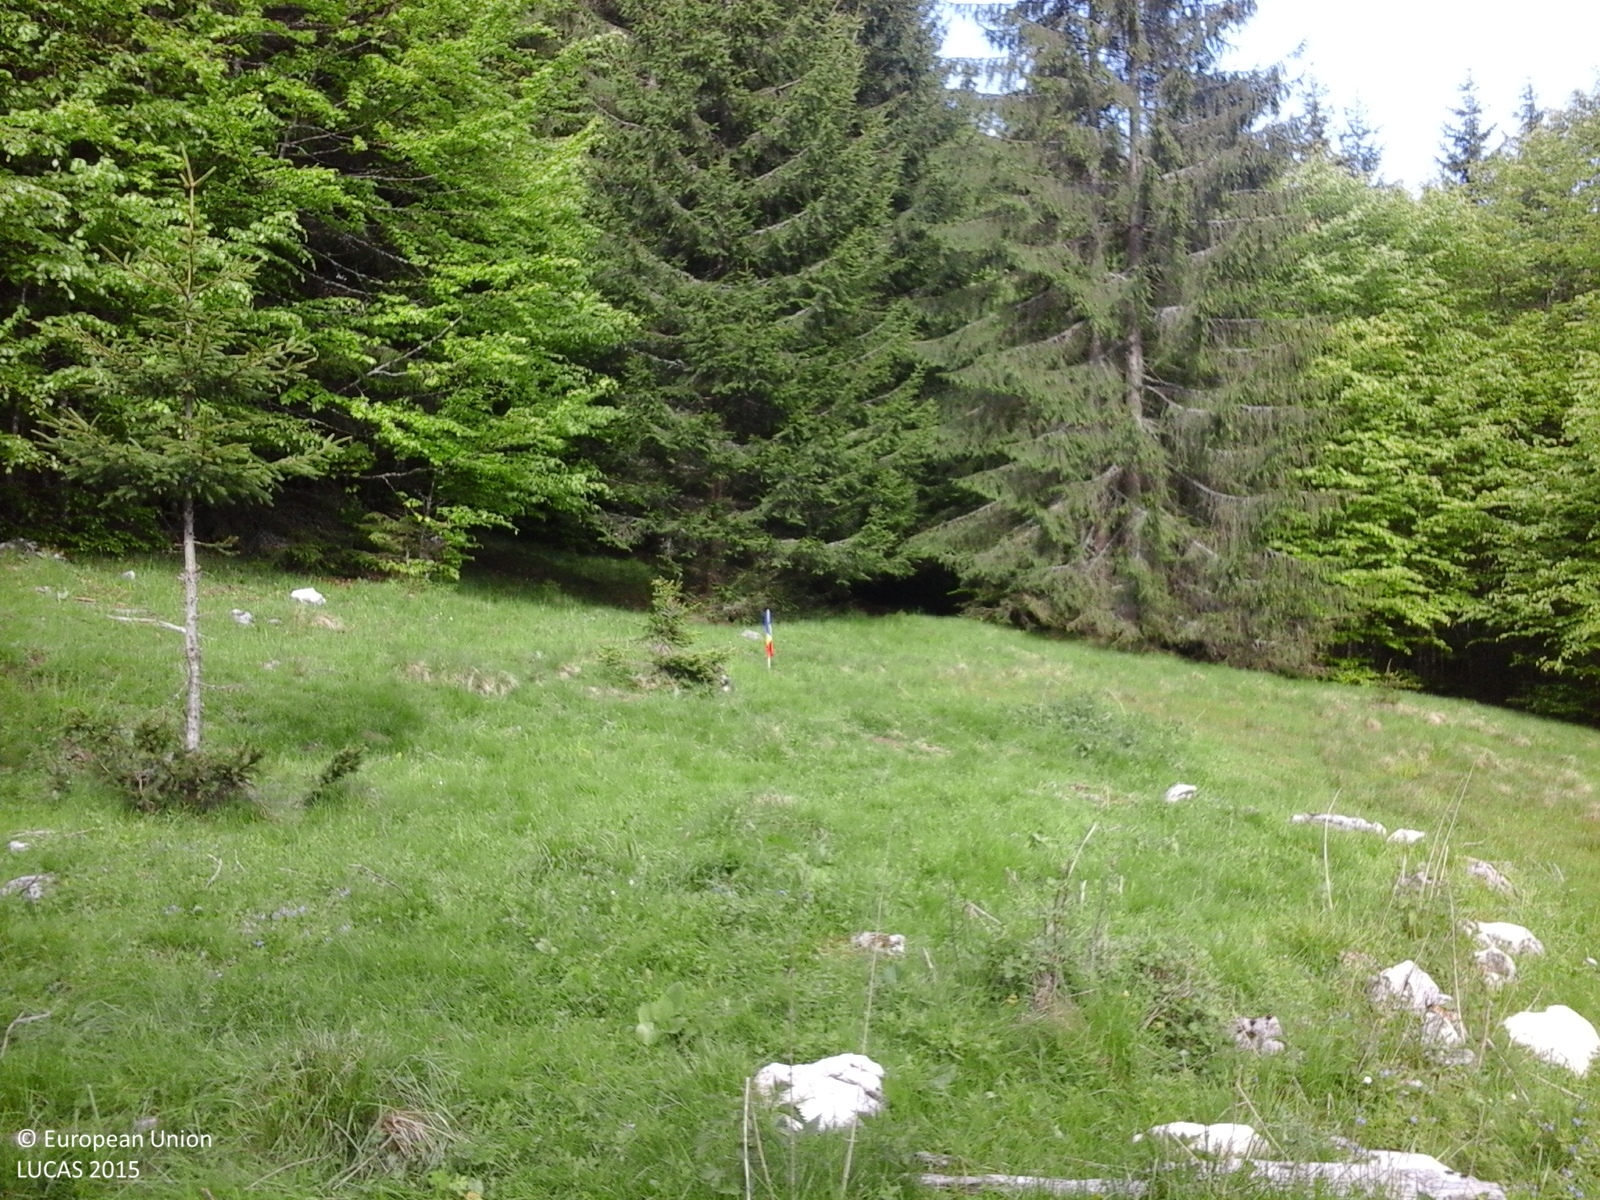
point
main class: Grassland
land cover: Grassland with sparse tree/shrub cover
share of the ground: > 75 %
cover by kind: herbaceous plants 90 %, coniferous forest trees 5 %, shrubs 5 %
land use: Forestry
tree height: < 5 m
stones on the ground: < 10 %
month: May
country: RO
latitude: 45.4904
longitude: 25.2318
